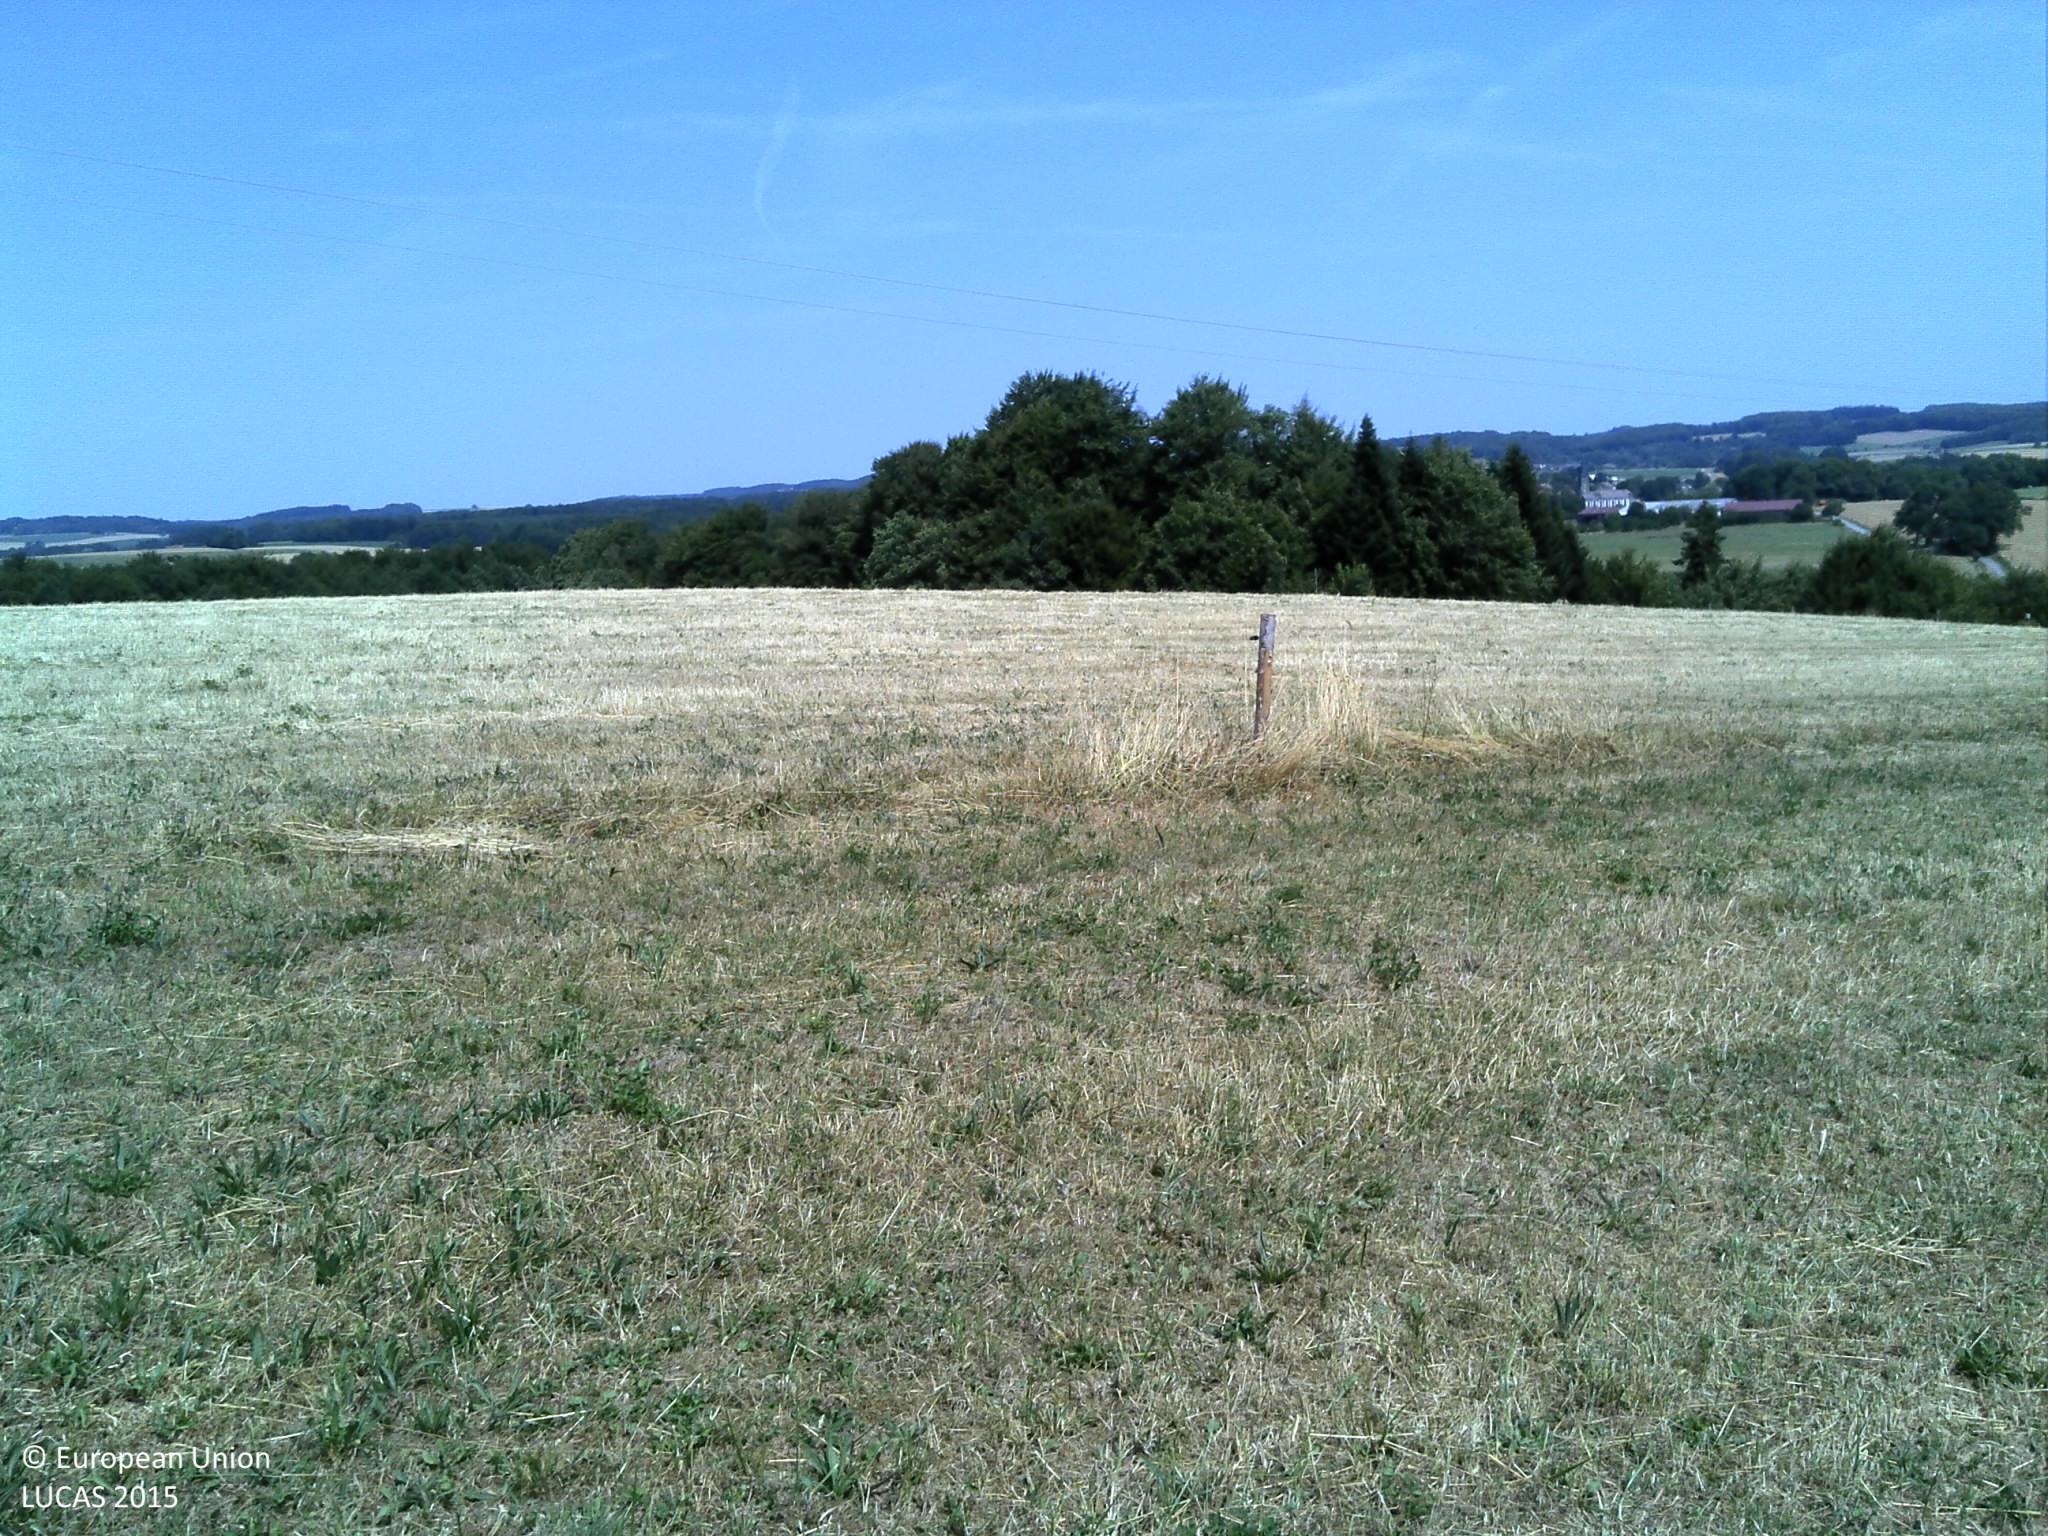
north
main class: Grassland
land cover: Grassland without tree/shrub cover
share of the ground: > 75 %
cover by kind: herbaceous plants 100 %
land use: Agriculture (excluding fallow land and kitchen gardens)
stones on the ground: < 10 %
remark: Harvested field
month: July
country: FR
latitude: 48.0726
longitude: 6.3367
